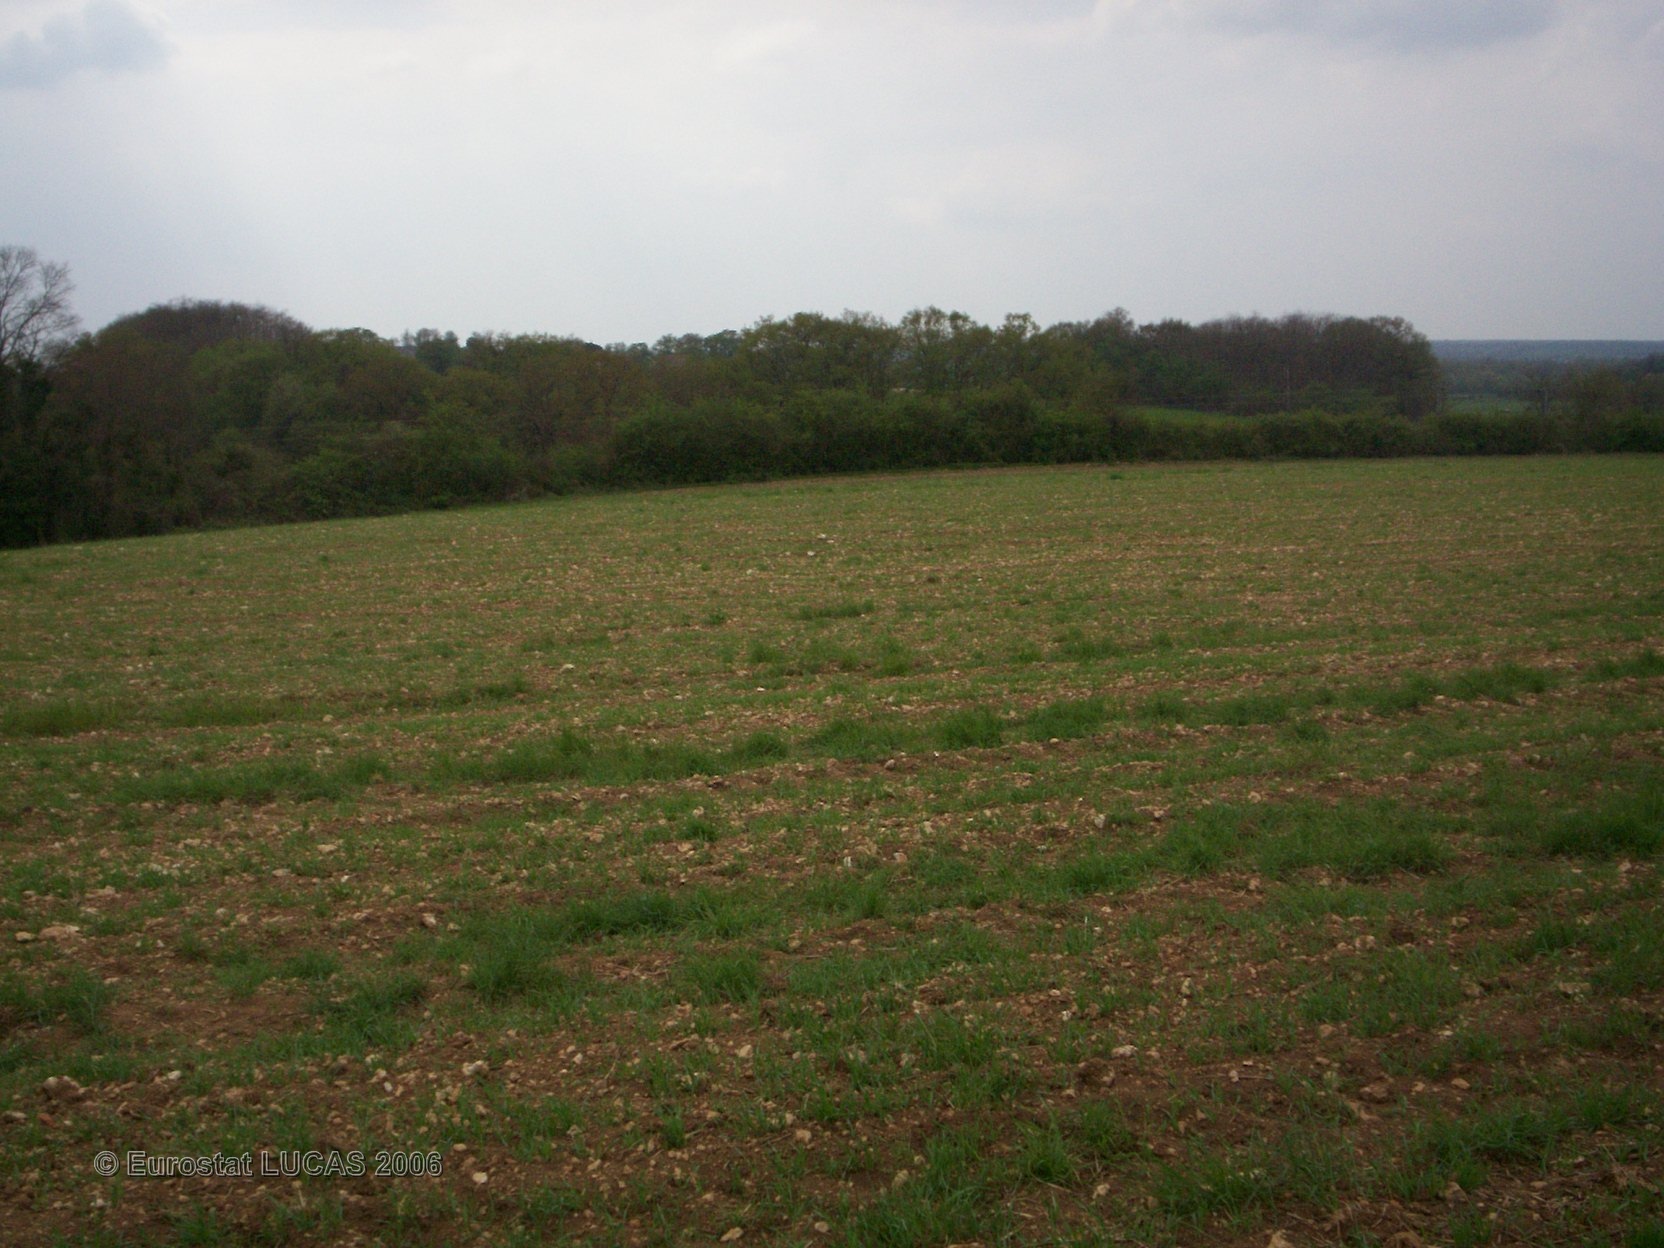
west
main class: Cropland
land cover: Barley
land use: Agriculture (excluding fallow land and kitchen gardens)
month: April
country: FR
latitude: 47.1189
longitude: 3.0495
